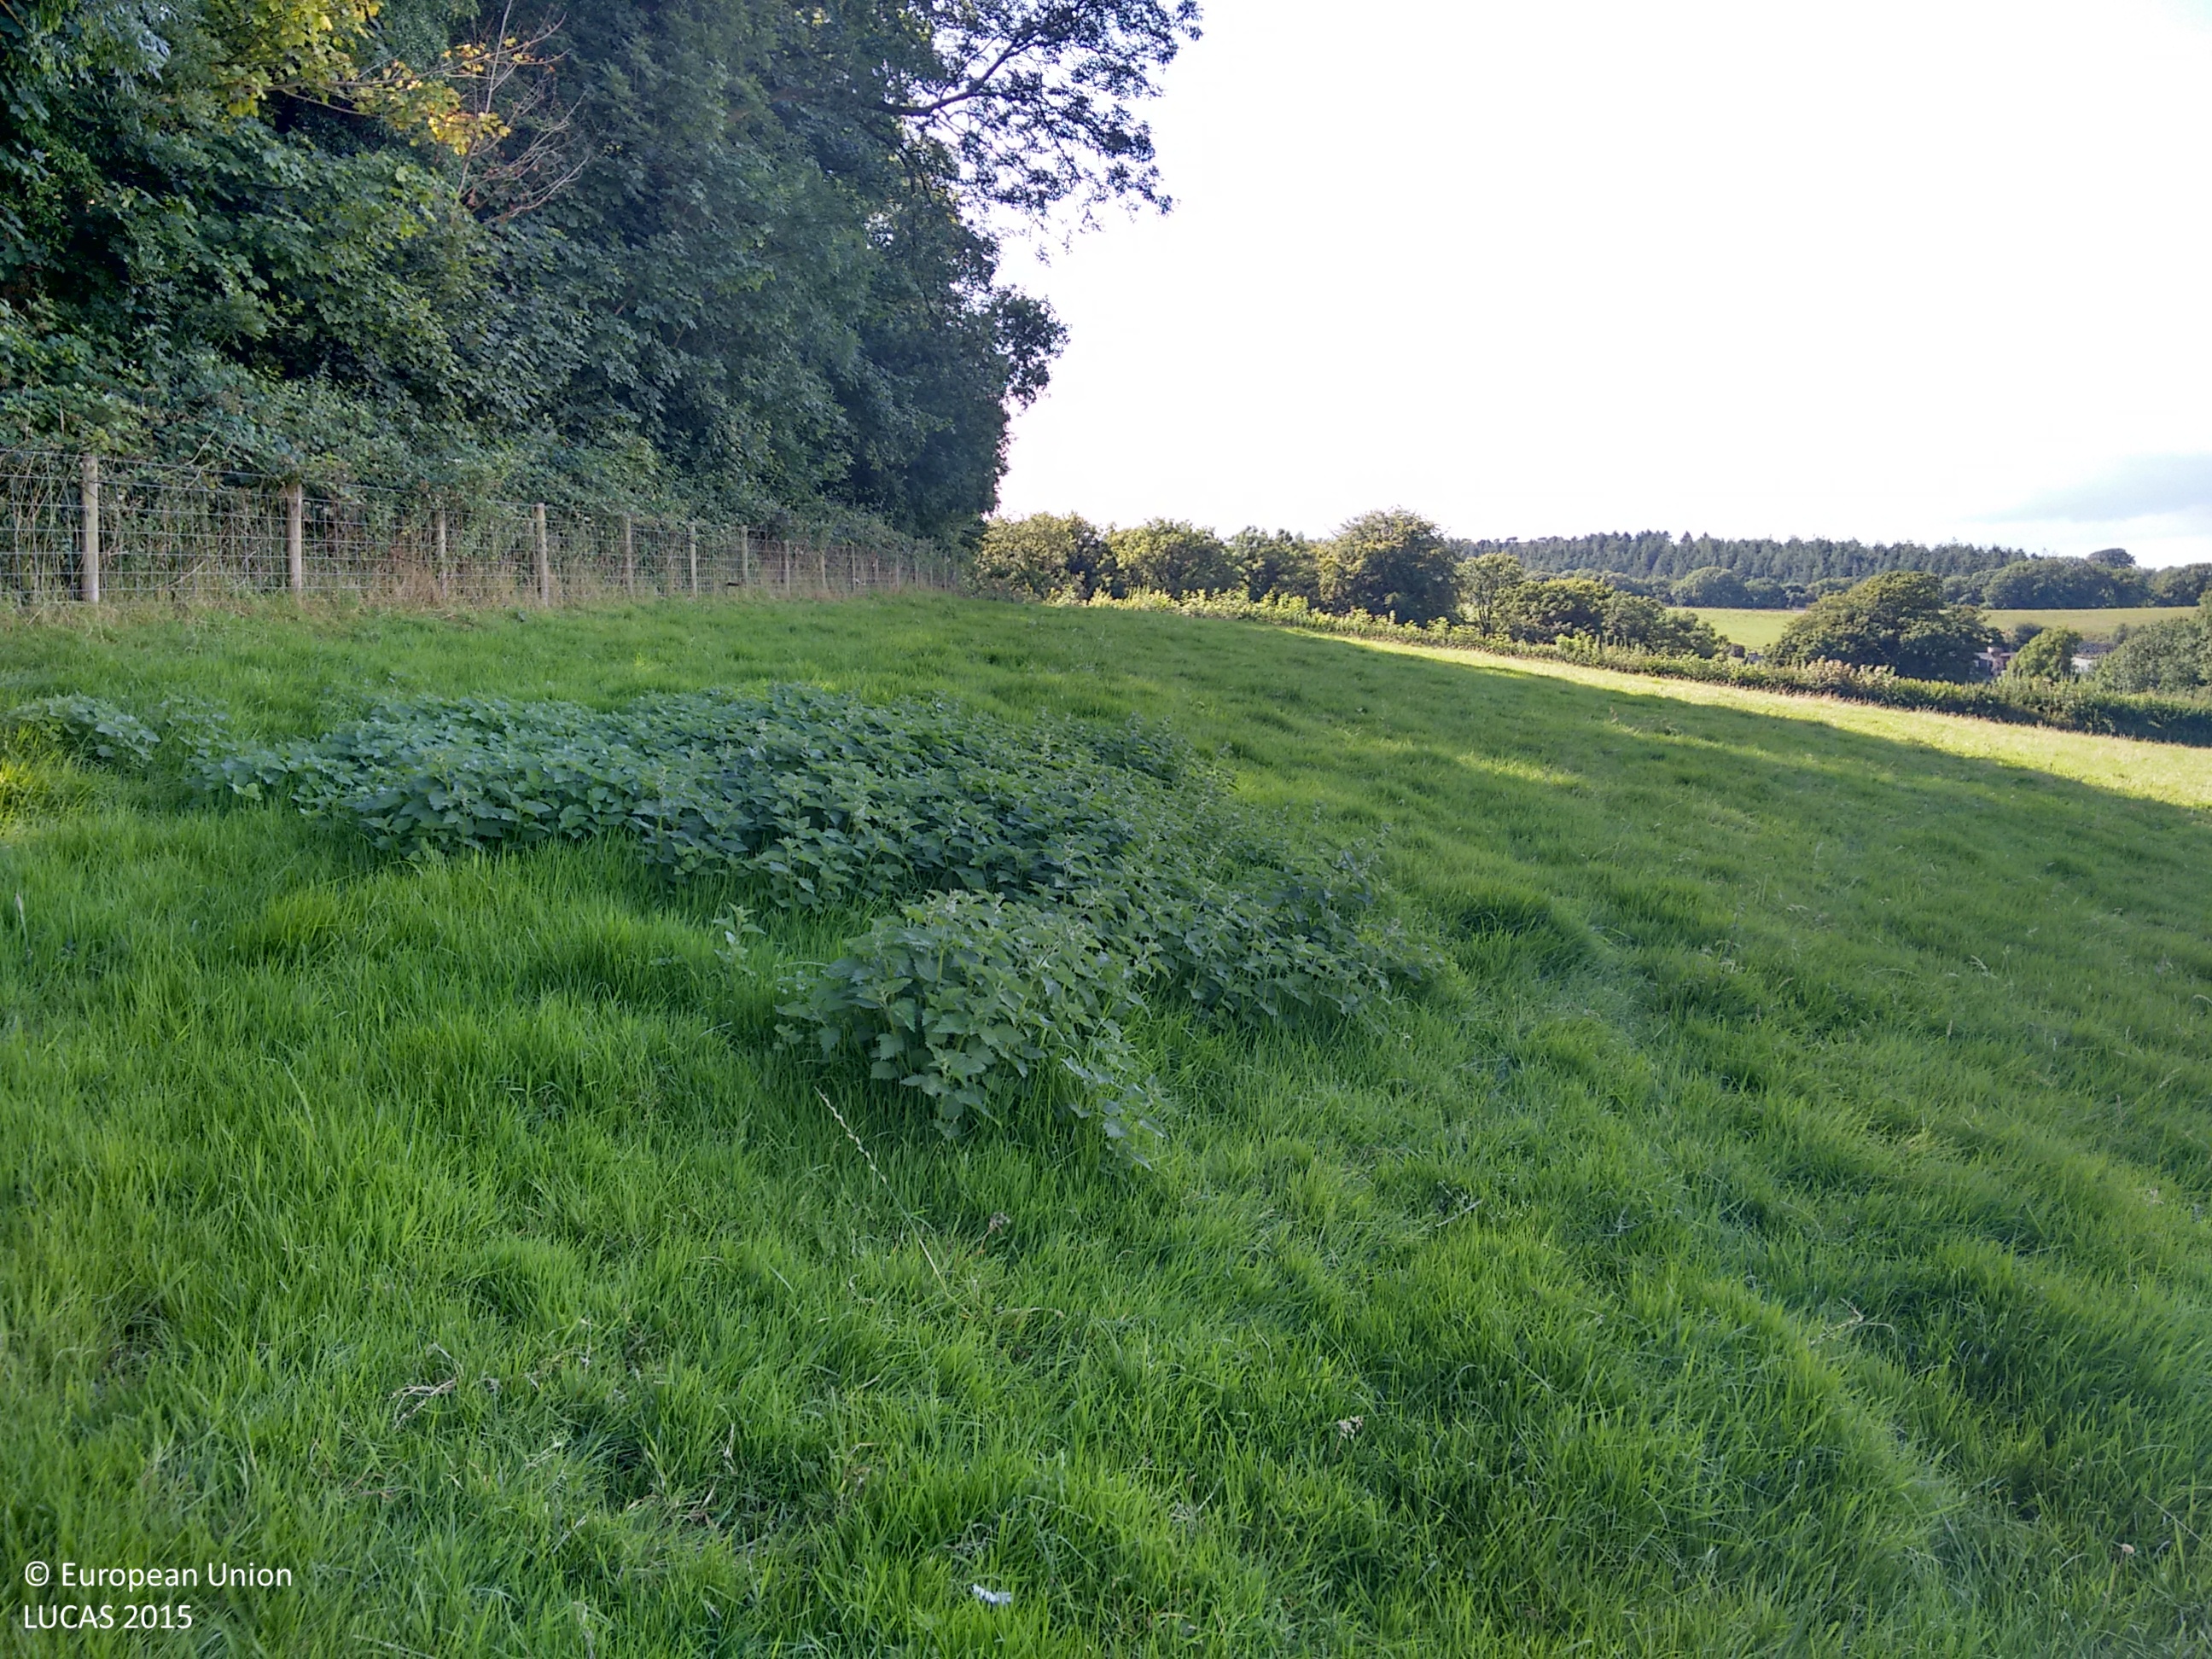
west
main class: Grassland
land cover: Grassland without tree/shrub cover
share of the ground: > 75 %
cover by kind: herbaceous plants 100 %
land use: Agriculture (excluding fallow land and kitchen gardens)
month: August
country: GB
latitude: 51.7736
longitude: -4.4966
